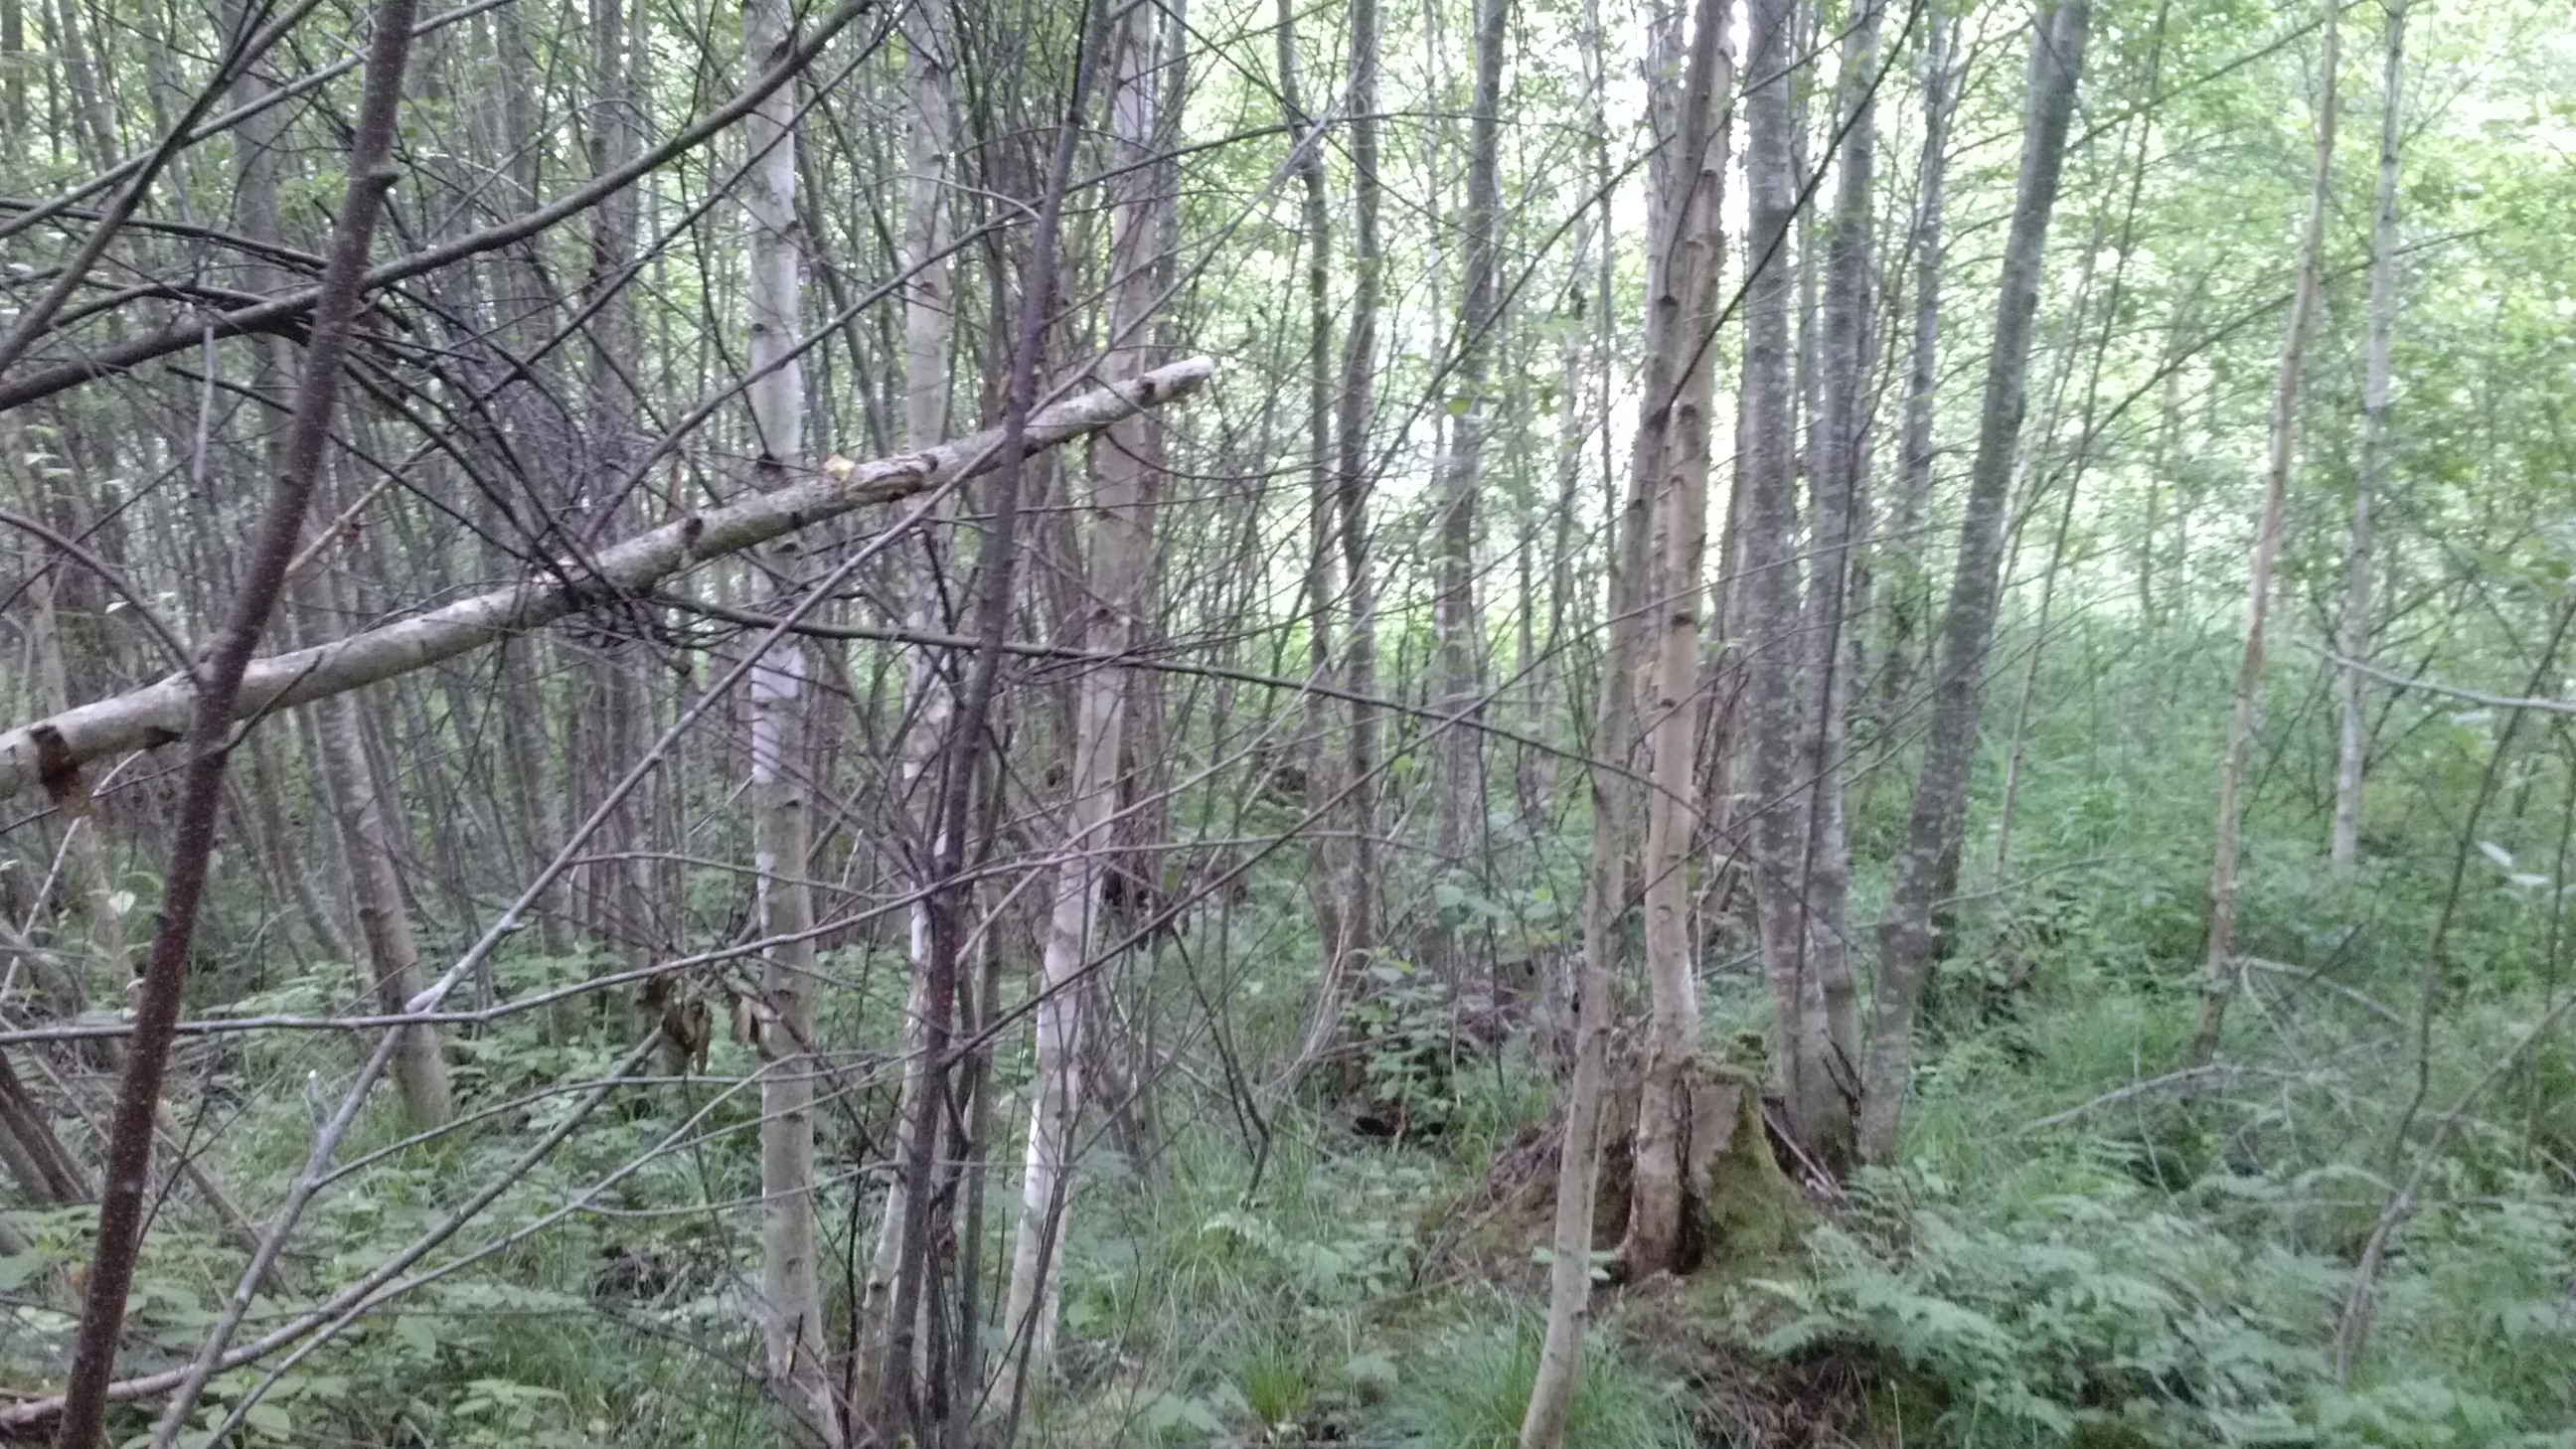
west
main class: Woodland
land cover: Broadleaved woodland
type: non-riverine alder, birch or aspen forest
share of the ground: > 75 %
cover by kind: broadleaved forest trees 80 %, herbaceous plants 15 %, shrubs 5 %
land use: Forestry
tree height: > 5 m
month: June
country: LV
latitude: 56.6082
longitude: 27.9354
